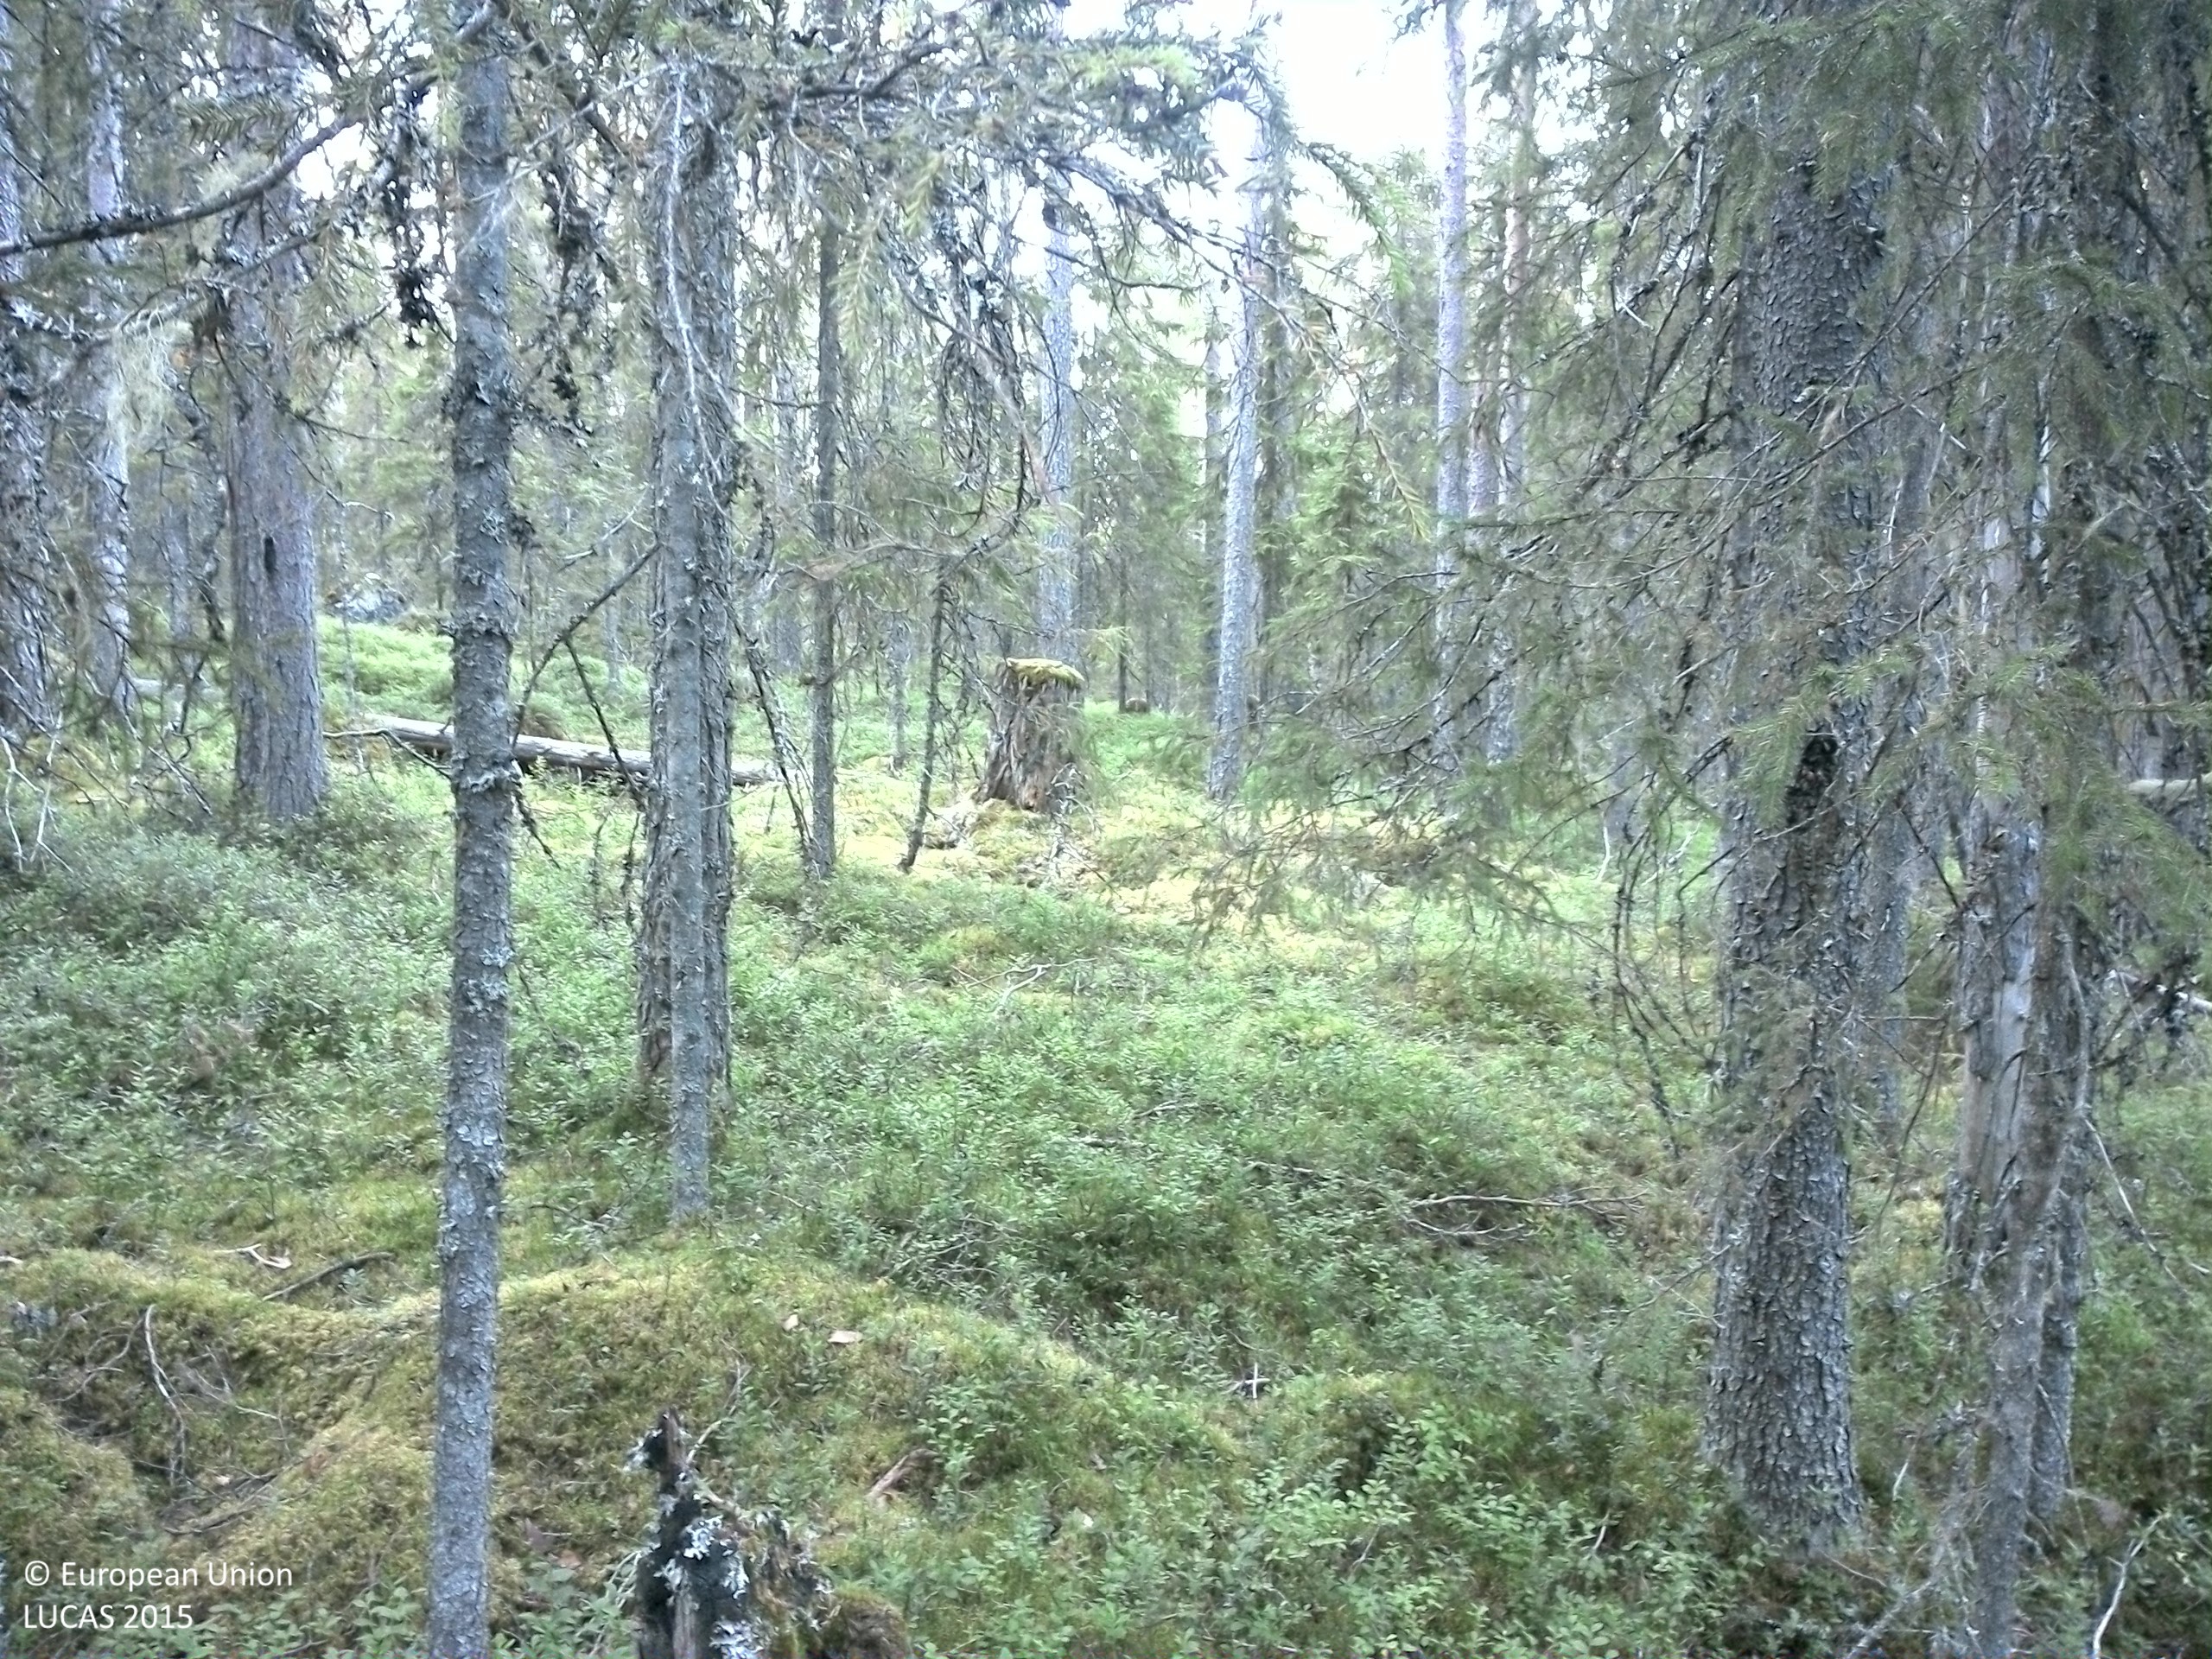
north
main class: Woodland
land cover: Other coniferous woodland
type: boreal forest
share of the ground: 25 - 50 %
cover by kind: coniferous forest trees 45 %, shrubs 40 %, lichens and mosses 15 %
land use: Forestry
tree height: > 5 m
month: August
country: SE
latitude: 63.8345
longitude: 16.8214
